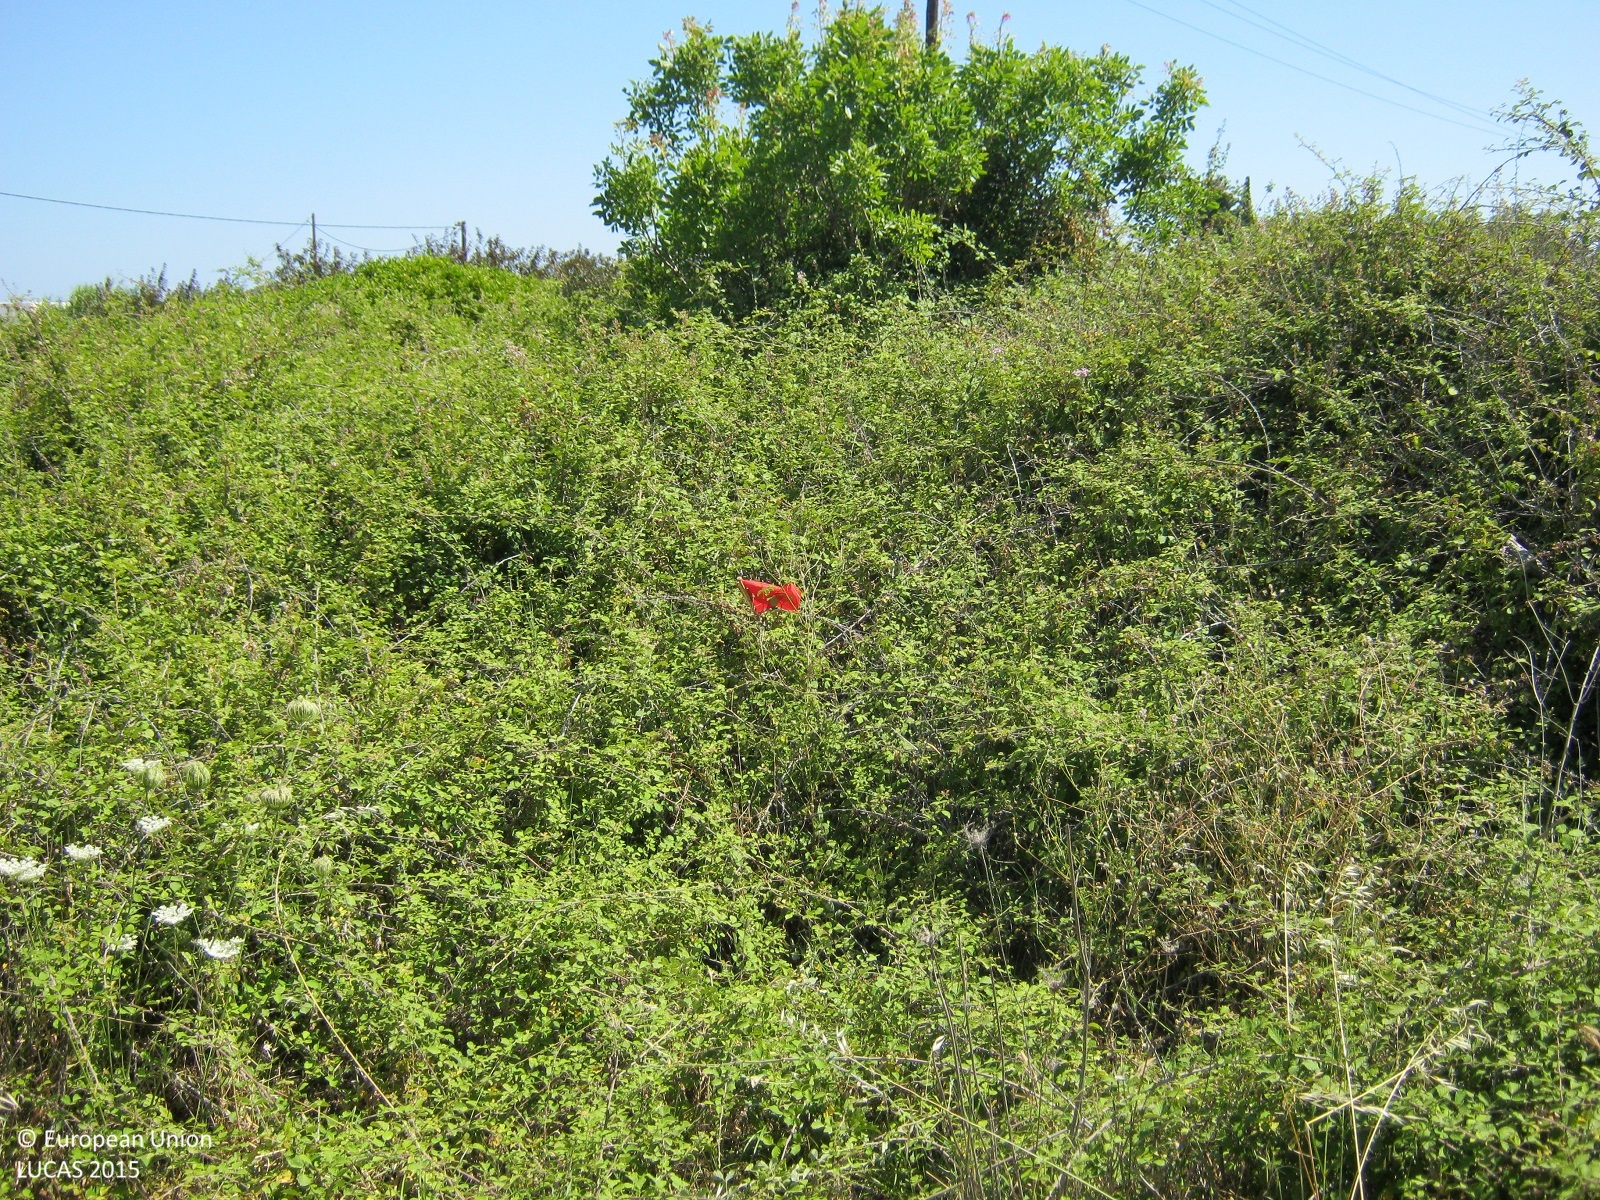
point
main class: Shrubland
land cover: Shrubland without tree cover
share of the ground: > 75 %
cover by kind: shrubs 90 %, herbaceous plants 10 %
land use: Semi-natural and natural areas not in use
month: June
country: GR
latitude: 36.4034
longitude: 28.0959
